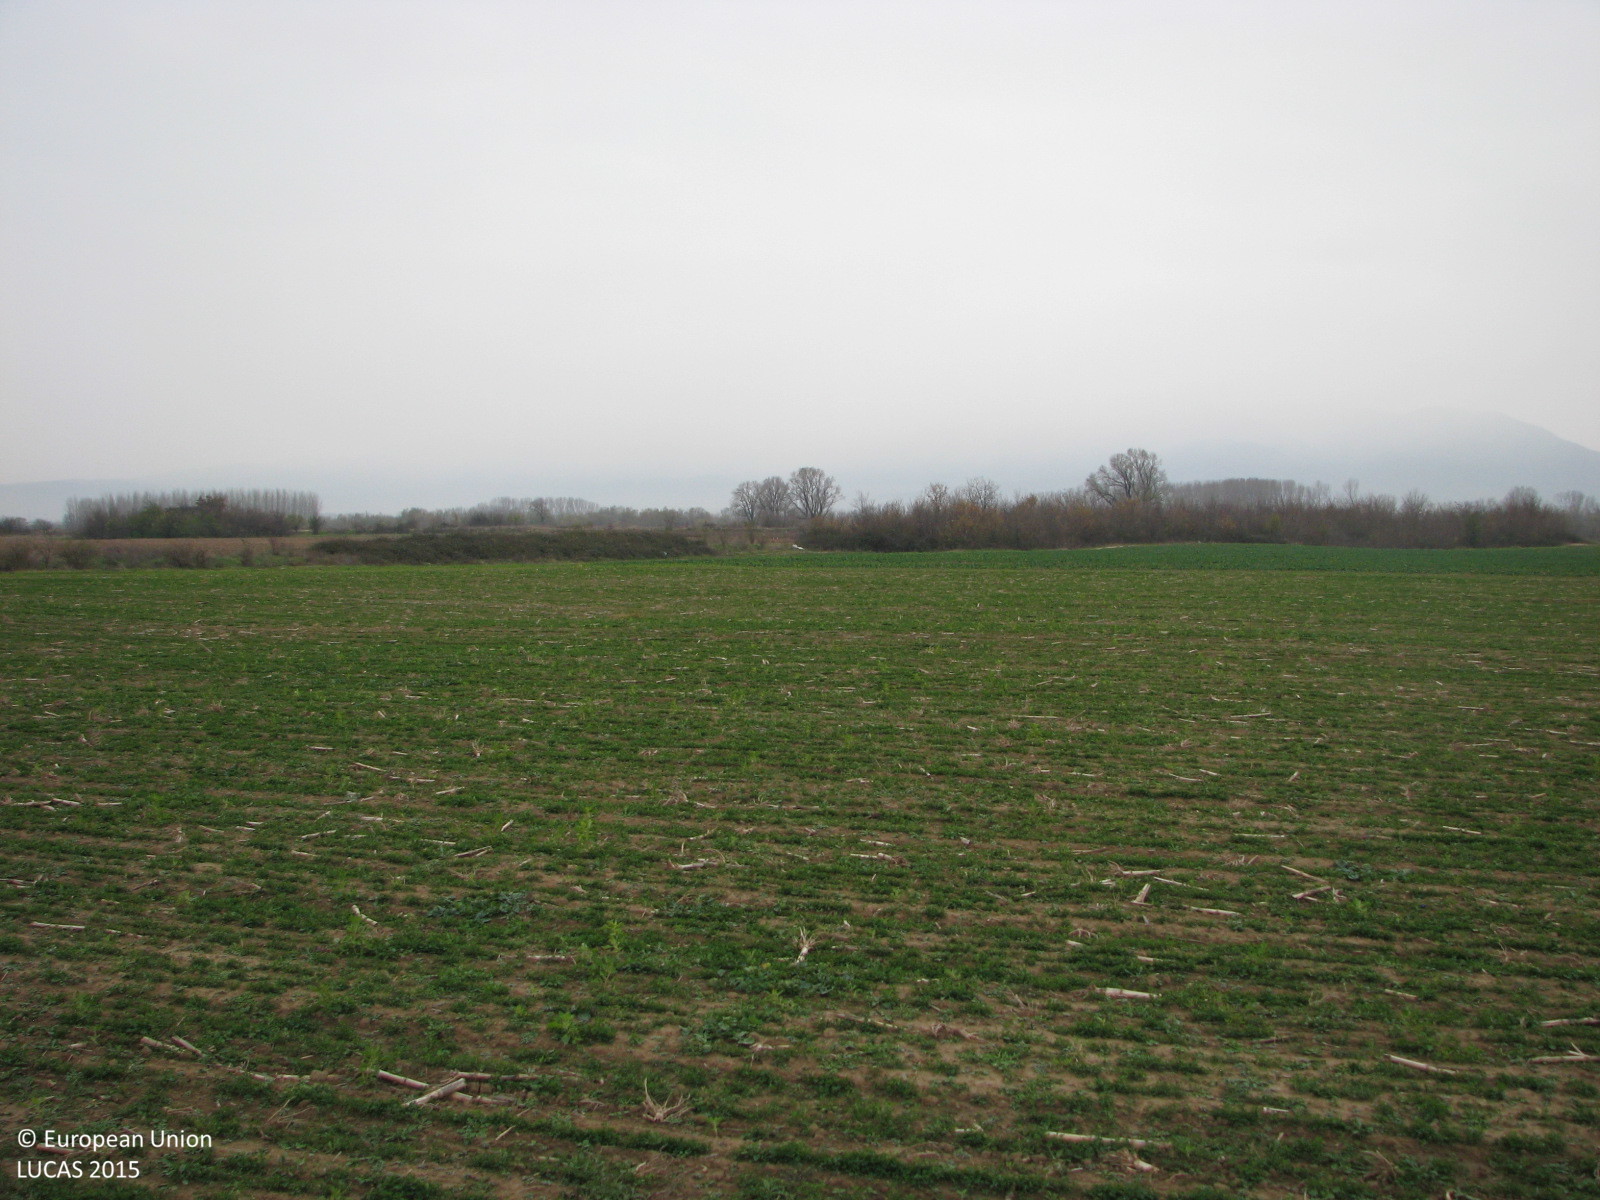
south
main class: Cropland
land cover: Maize
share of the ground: < 10 %
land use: Agriculture (excluding fallow land and kitchen gardens)
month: December
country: BG
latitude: 42.2325
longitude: 24.2079
